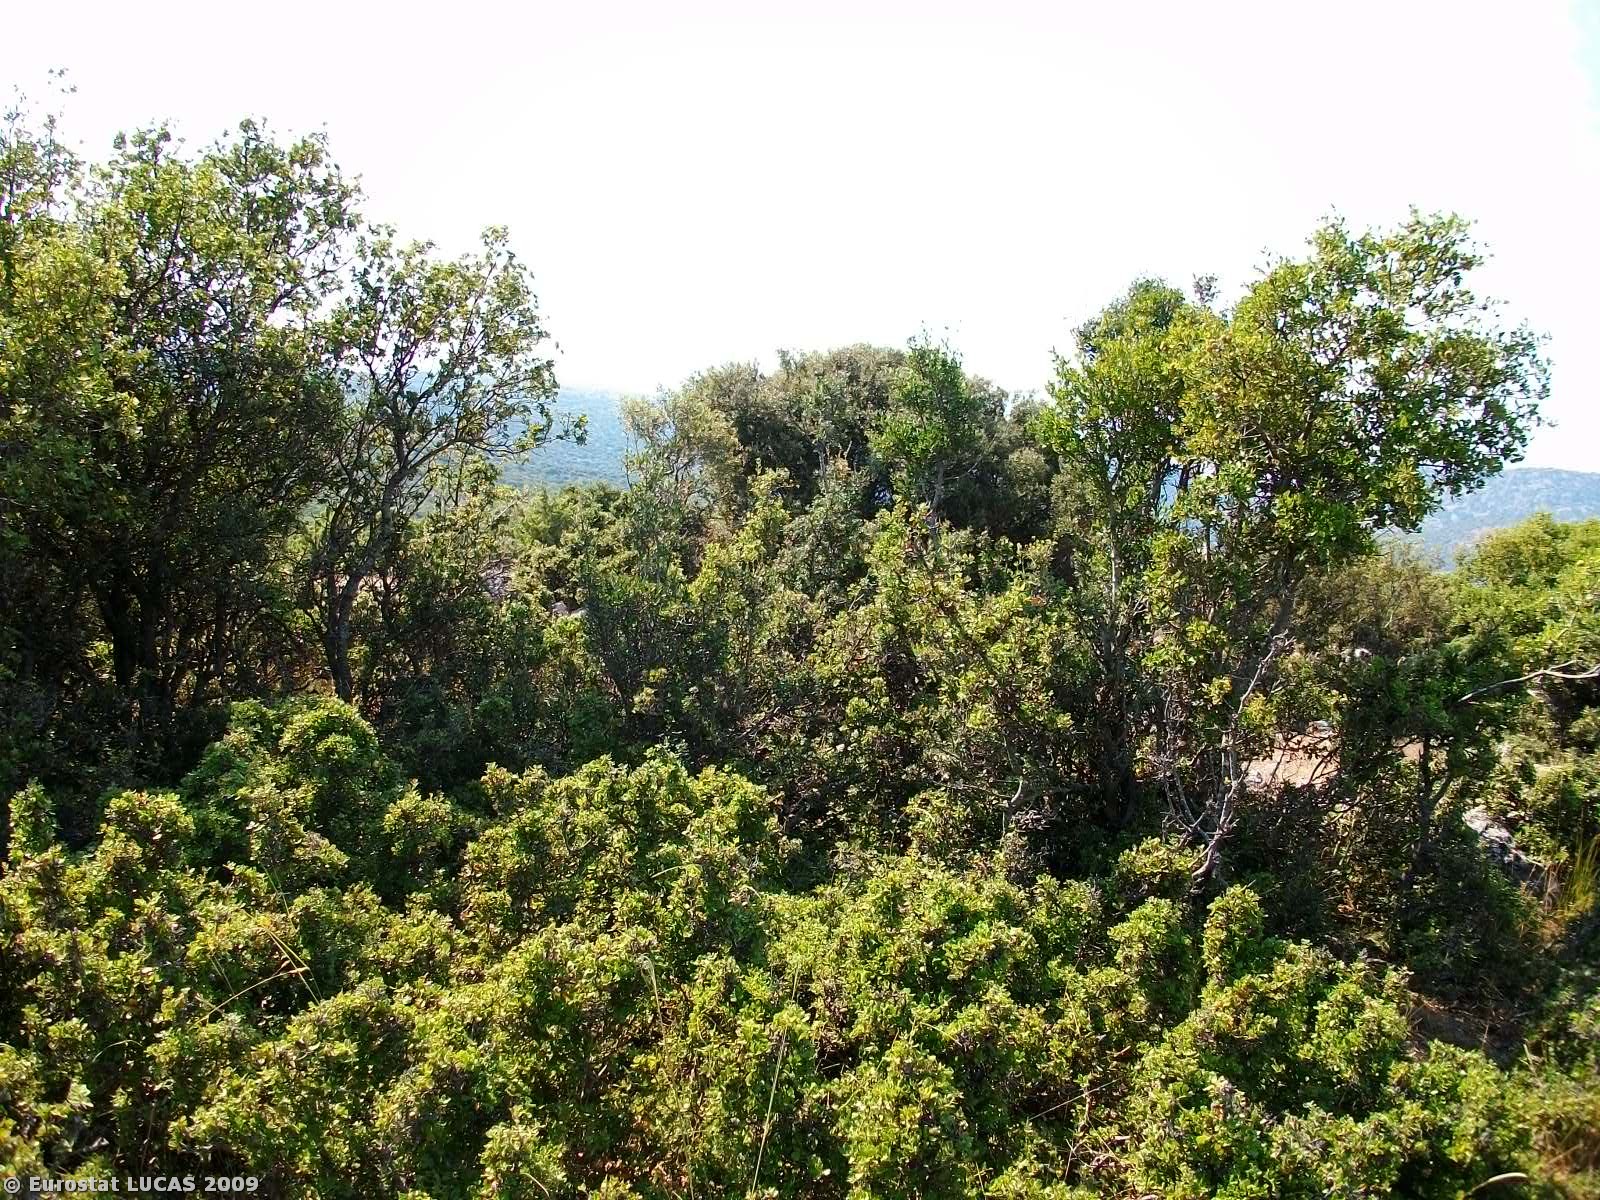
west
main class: Shrubland
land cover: Shrubland without tree cover
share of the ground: > 75 %
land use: Unused
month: July
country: GR
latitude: 40.1566
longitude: 21.7891
